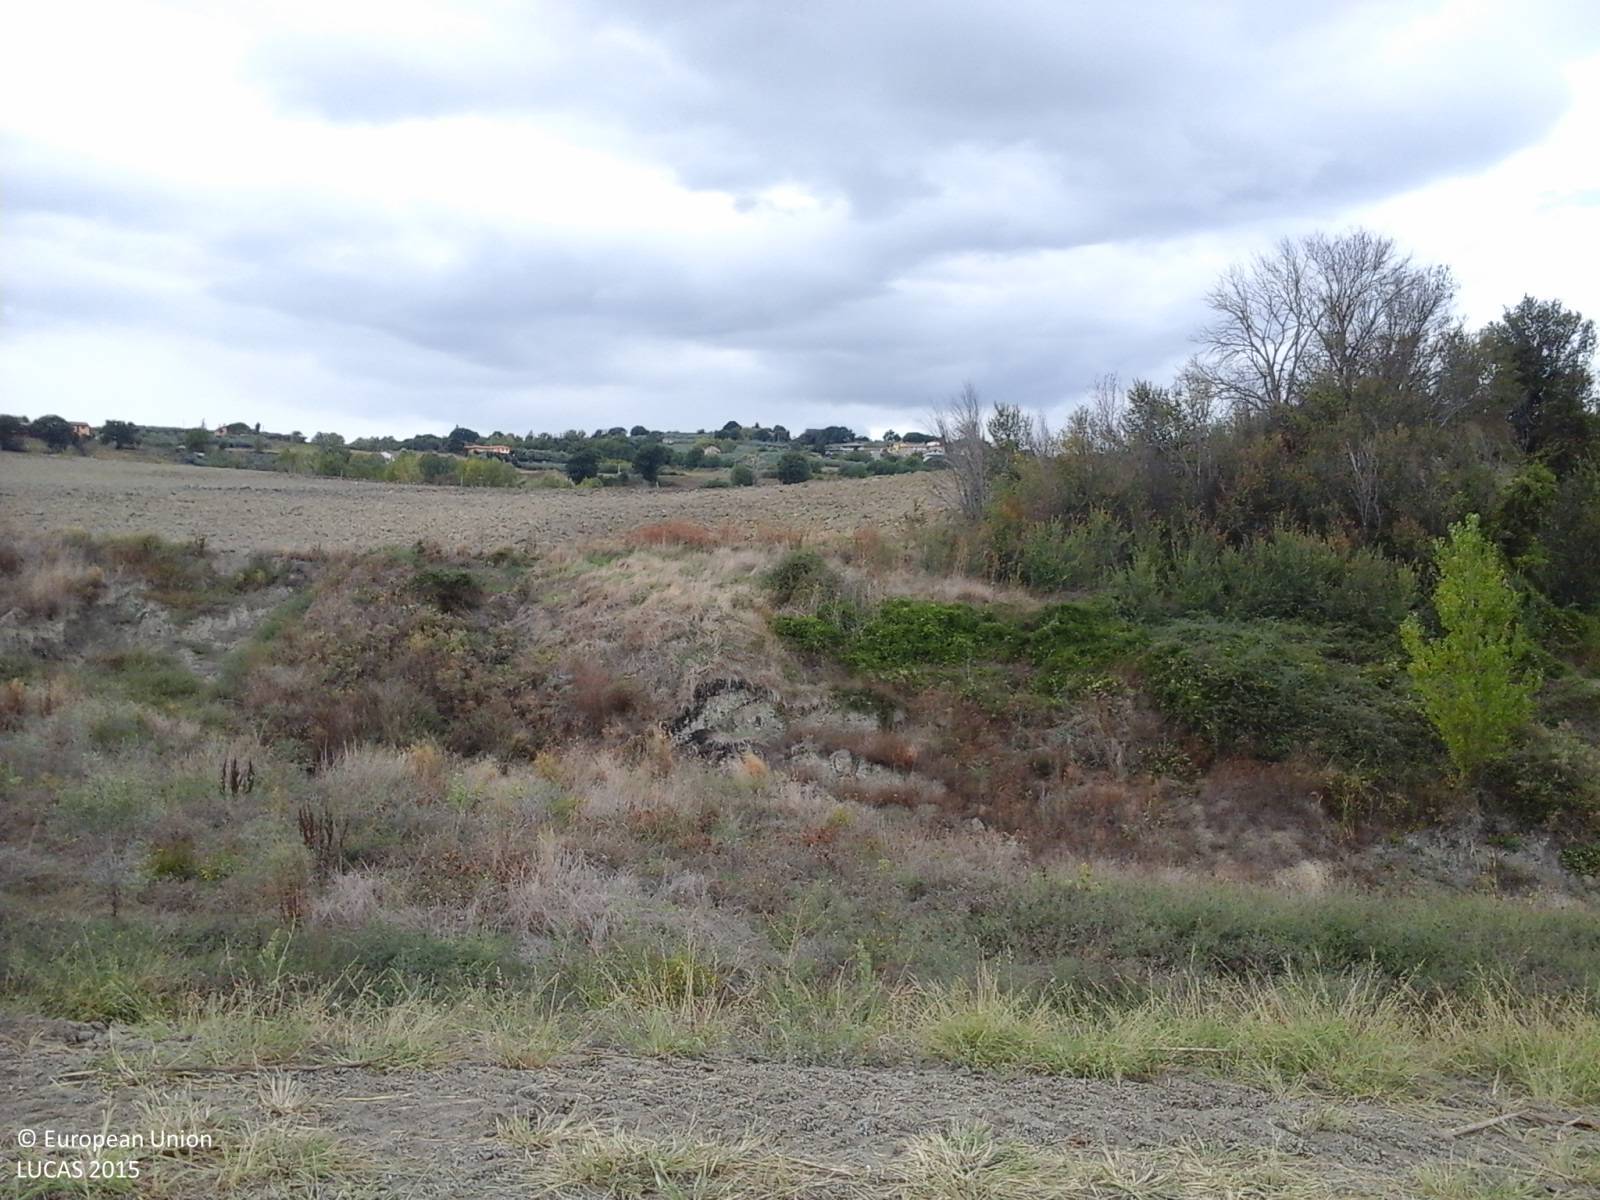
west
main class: Cropland
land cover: Sunflower
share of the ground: > 75 %
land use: Agriculture (excluding fallow land and kitchen gardens)
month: September
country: IT
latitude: 42.8935
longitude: 12.5272
